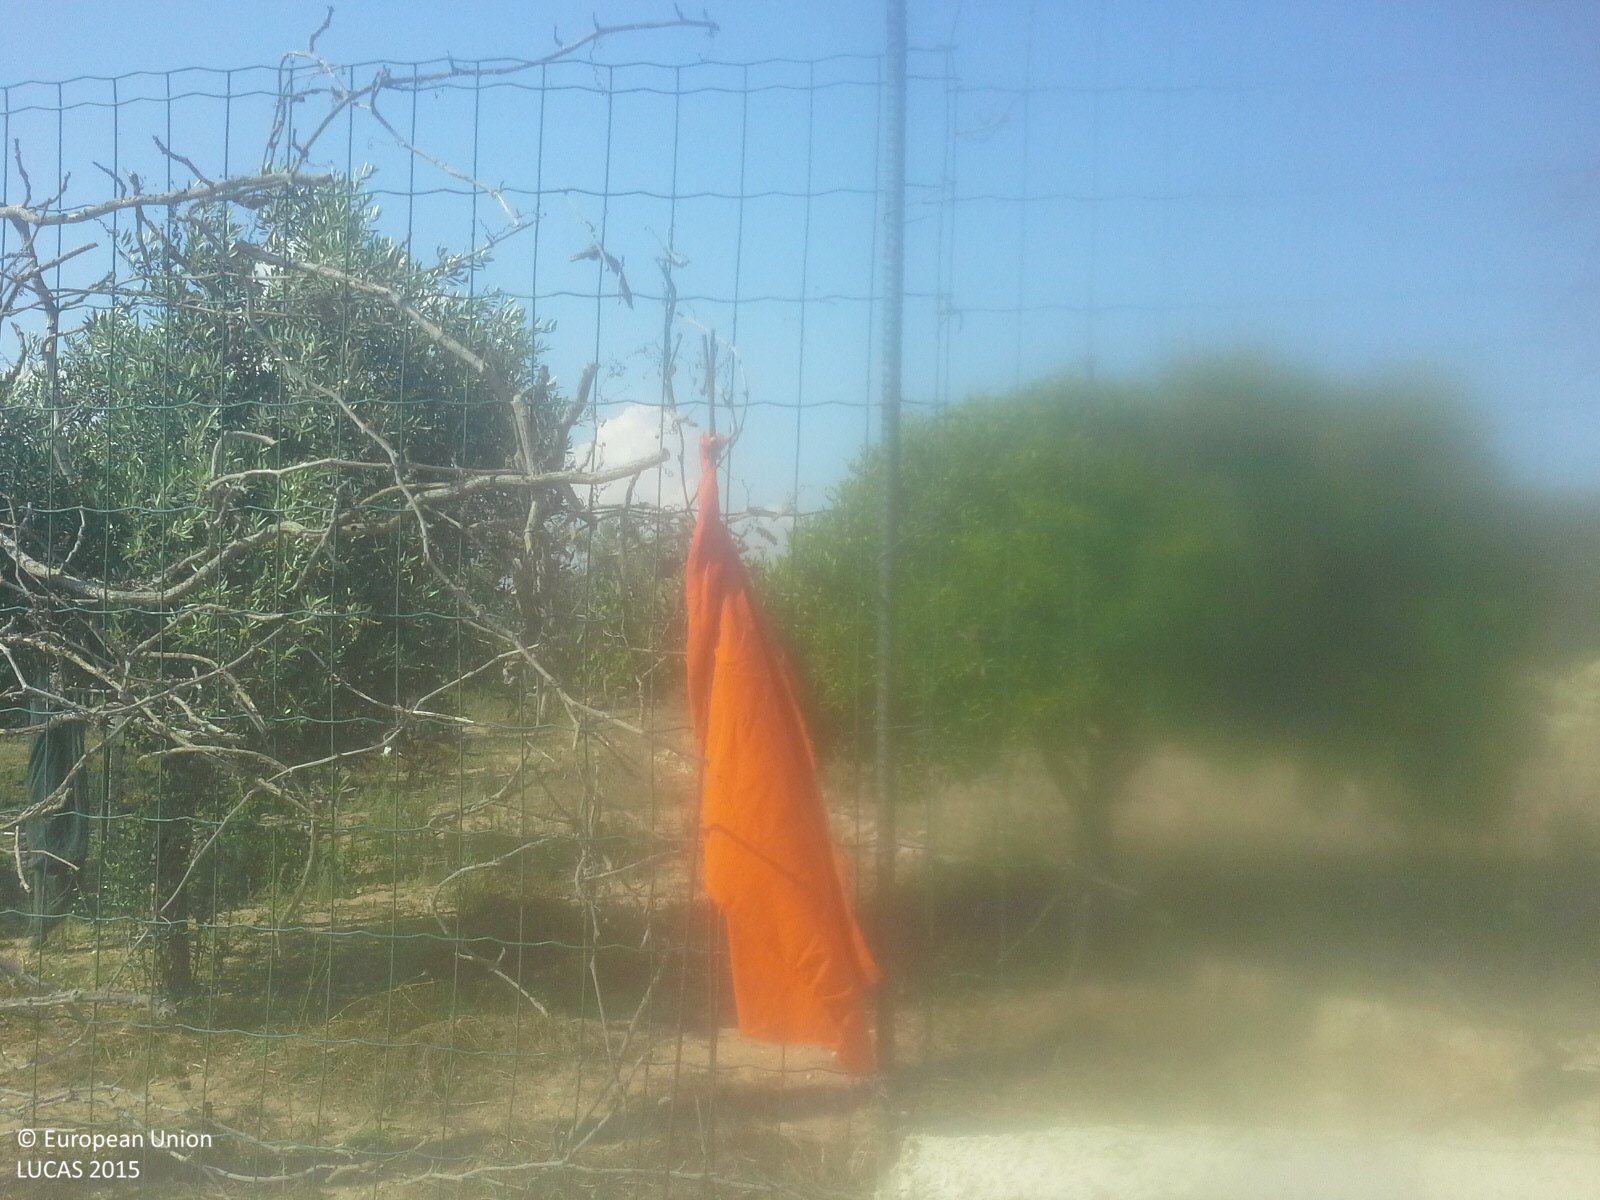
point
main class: Cropland
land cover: Olive groves
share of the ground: > 75 %
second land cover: Spontaneously vegetated surfaces
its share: > 75 %
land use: Agriculture (excluding fallow land and kitchen gardens)
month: June
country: IT
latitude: 36.7186
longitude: 14.7641
